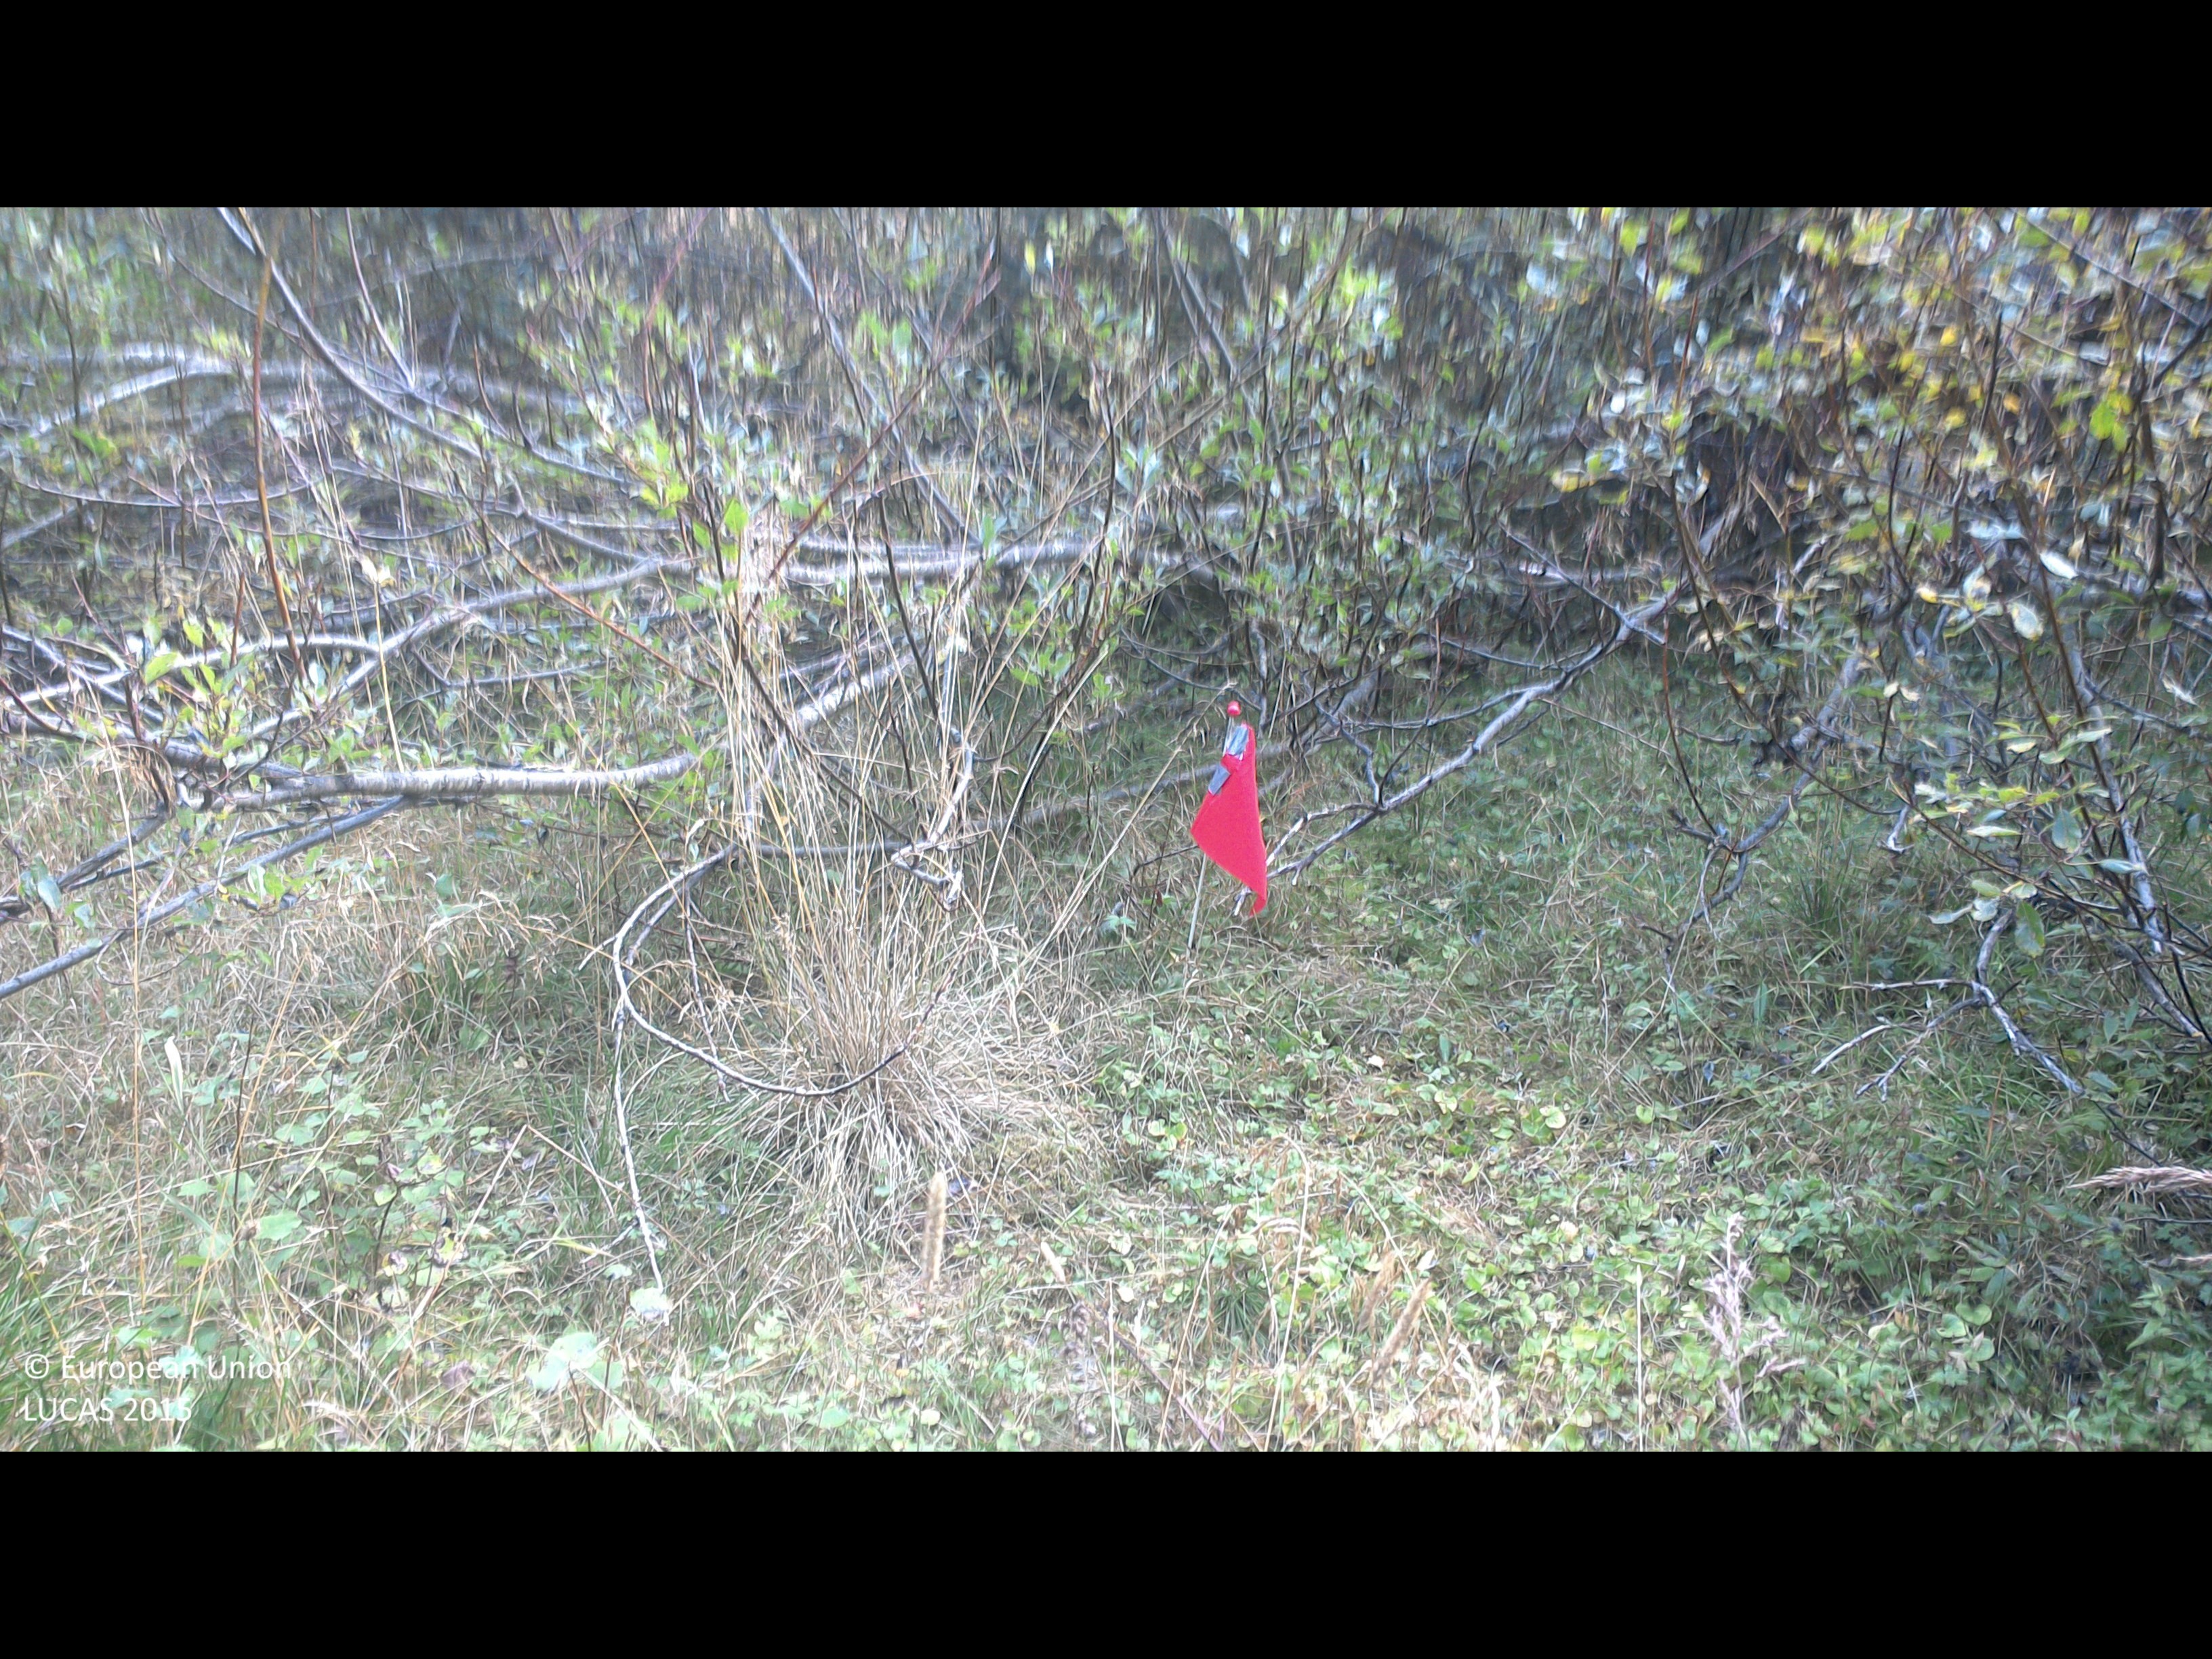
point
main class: Woodland
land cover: Broadleaved woodland
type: boreal forest
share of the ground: 50 - 75 %
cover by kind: broadleaved forest trees 60 %, herbaceous plants 40 %
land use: Semi-natural and natural areas not in use
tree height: > 5 m
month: September
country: SE
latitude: 63.8034
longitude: 19.4999
